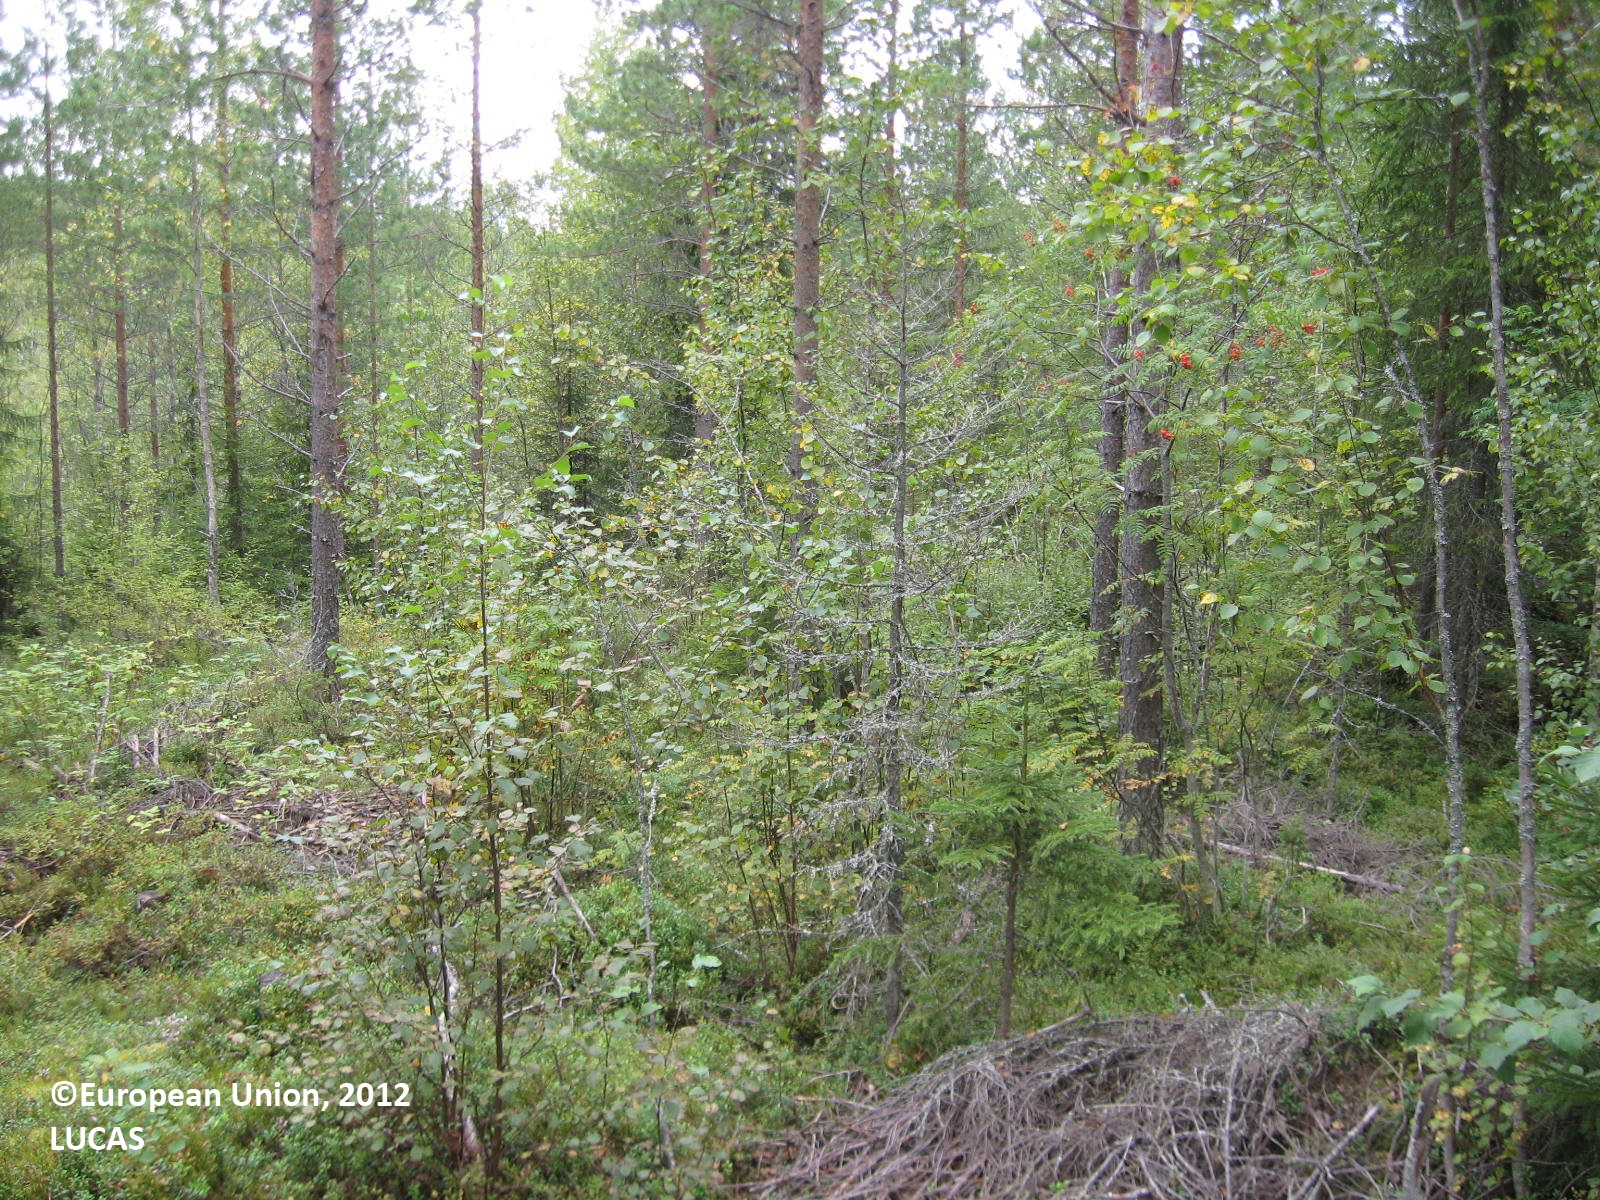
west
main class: Woodland
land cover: Pine dominated mixed woodland
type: boreal forest
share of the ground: 50 - 75 %
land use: Forestry
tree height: > 5 m
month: August
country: FI
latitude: 63.6827
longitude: 29.2808
